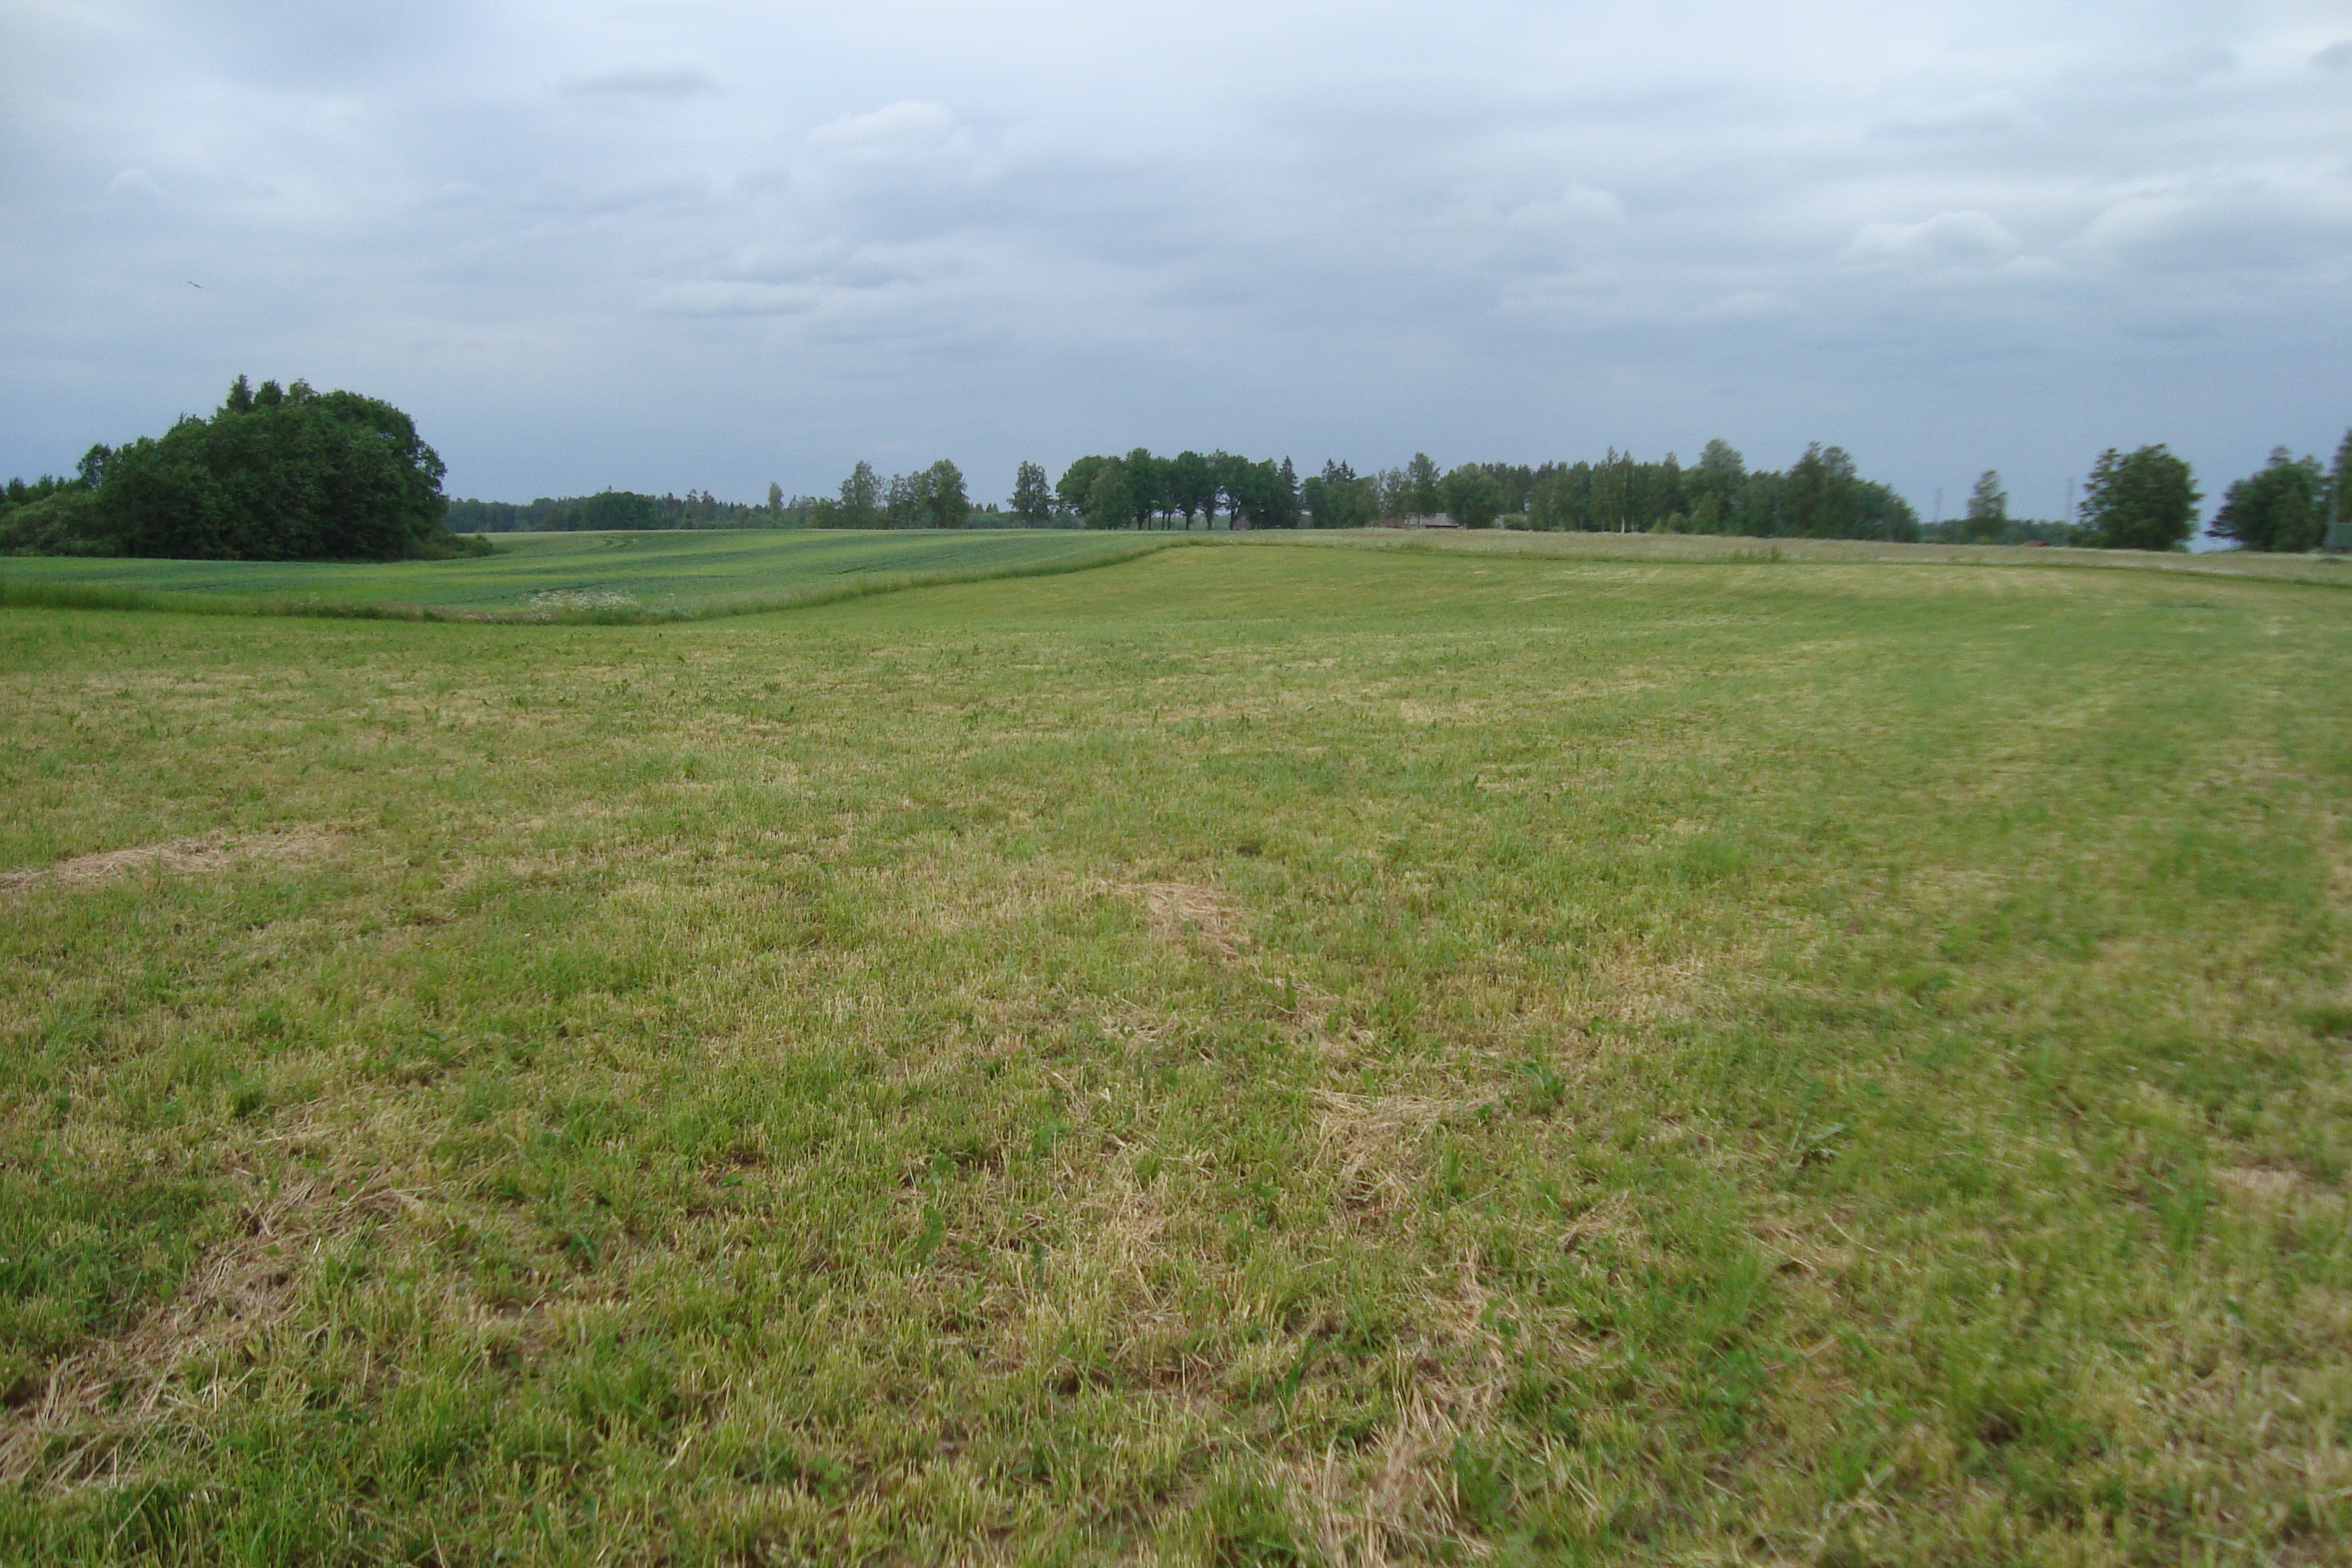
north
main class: Cropland
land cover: Lucerne
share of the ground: > 75 %
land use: Agriculture (excluding fallow land and kitchen gardens)
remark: Harvested field
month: June
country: LV
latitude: 57.2038
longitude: 26.3796
